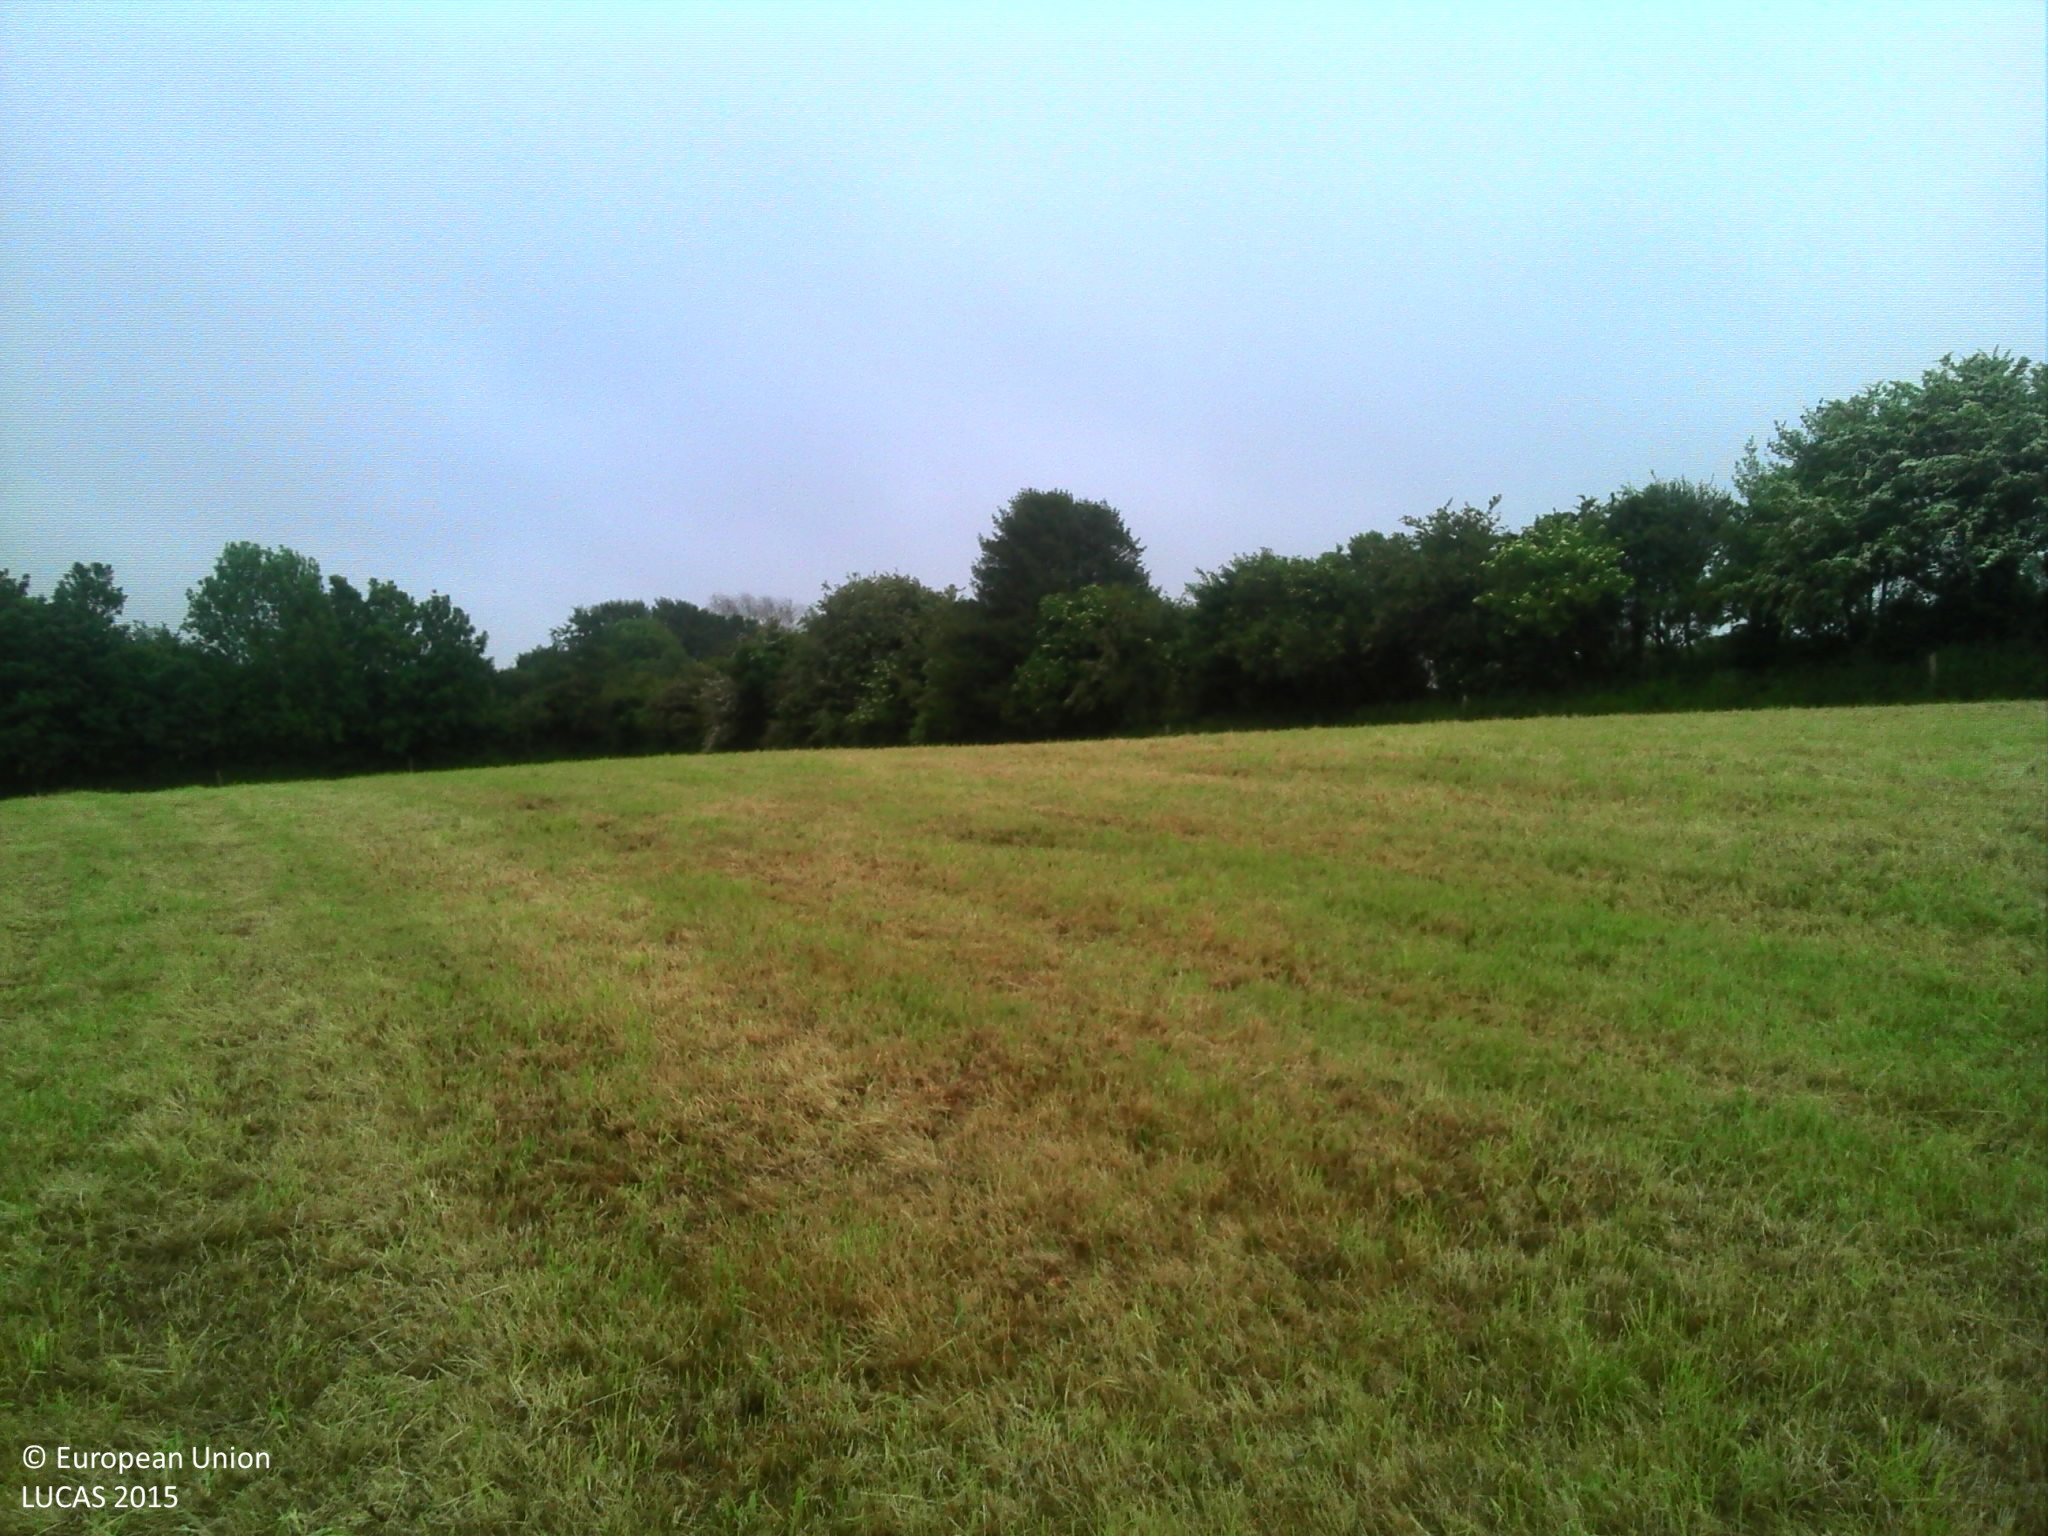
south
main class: Grassland
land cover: Grassland without tree/shrub cover
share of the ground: > 75 %
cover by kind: herbaceous plants 100 %
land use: Agriculture (excluding fallow land and kitchen gardens)
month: June
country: FR
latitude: 49.5668
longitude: -1.8207
